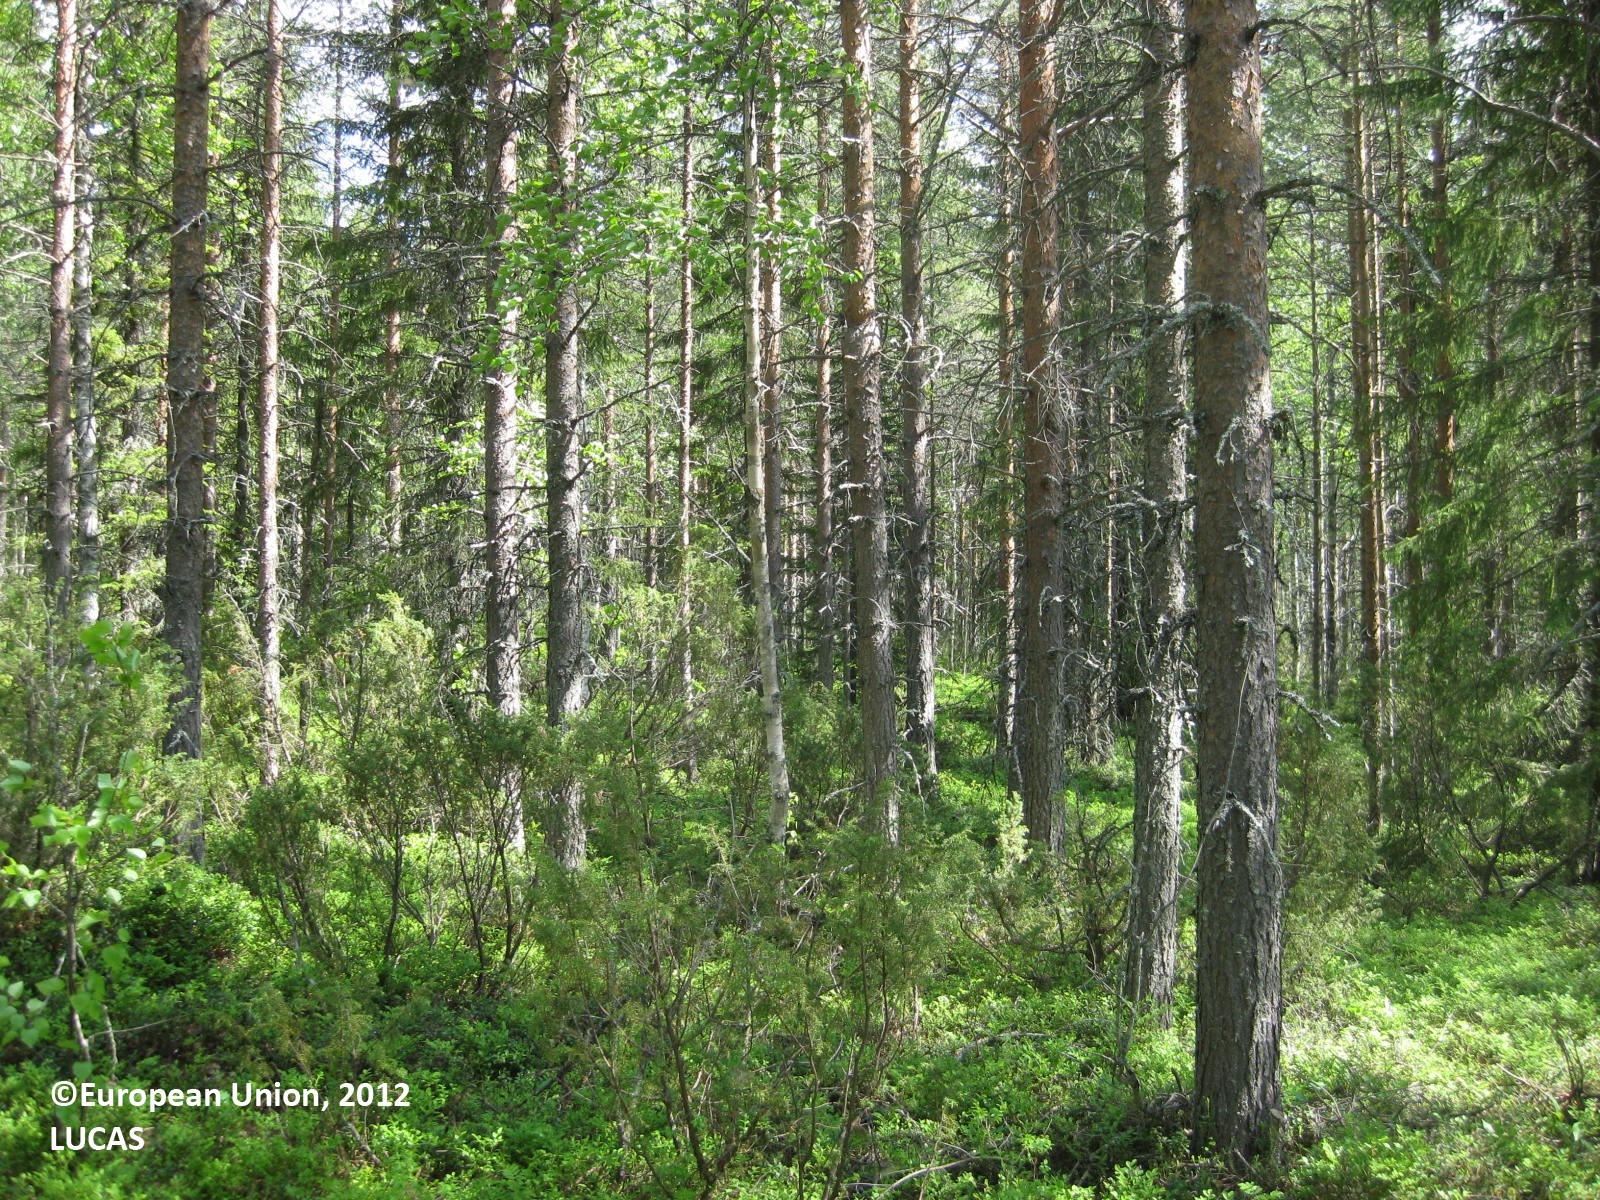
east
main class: Woodland
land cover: Pine dominated mixed woodland
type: boreal forest
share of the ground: > 75 %
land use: Forestry
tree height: > 5 m
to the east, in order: Pine dominated mixed woodland; Pine dominated coniferous woodland; Other mixed woodland; Pine dominated mixed woodland; Other mixed woodland
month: June
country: FI
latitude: 65.0146
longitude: 28.9635
